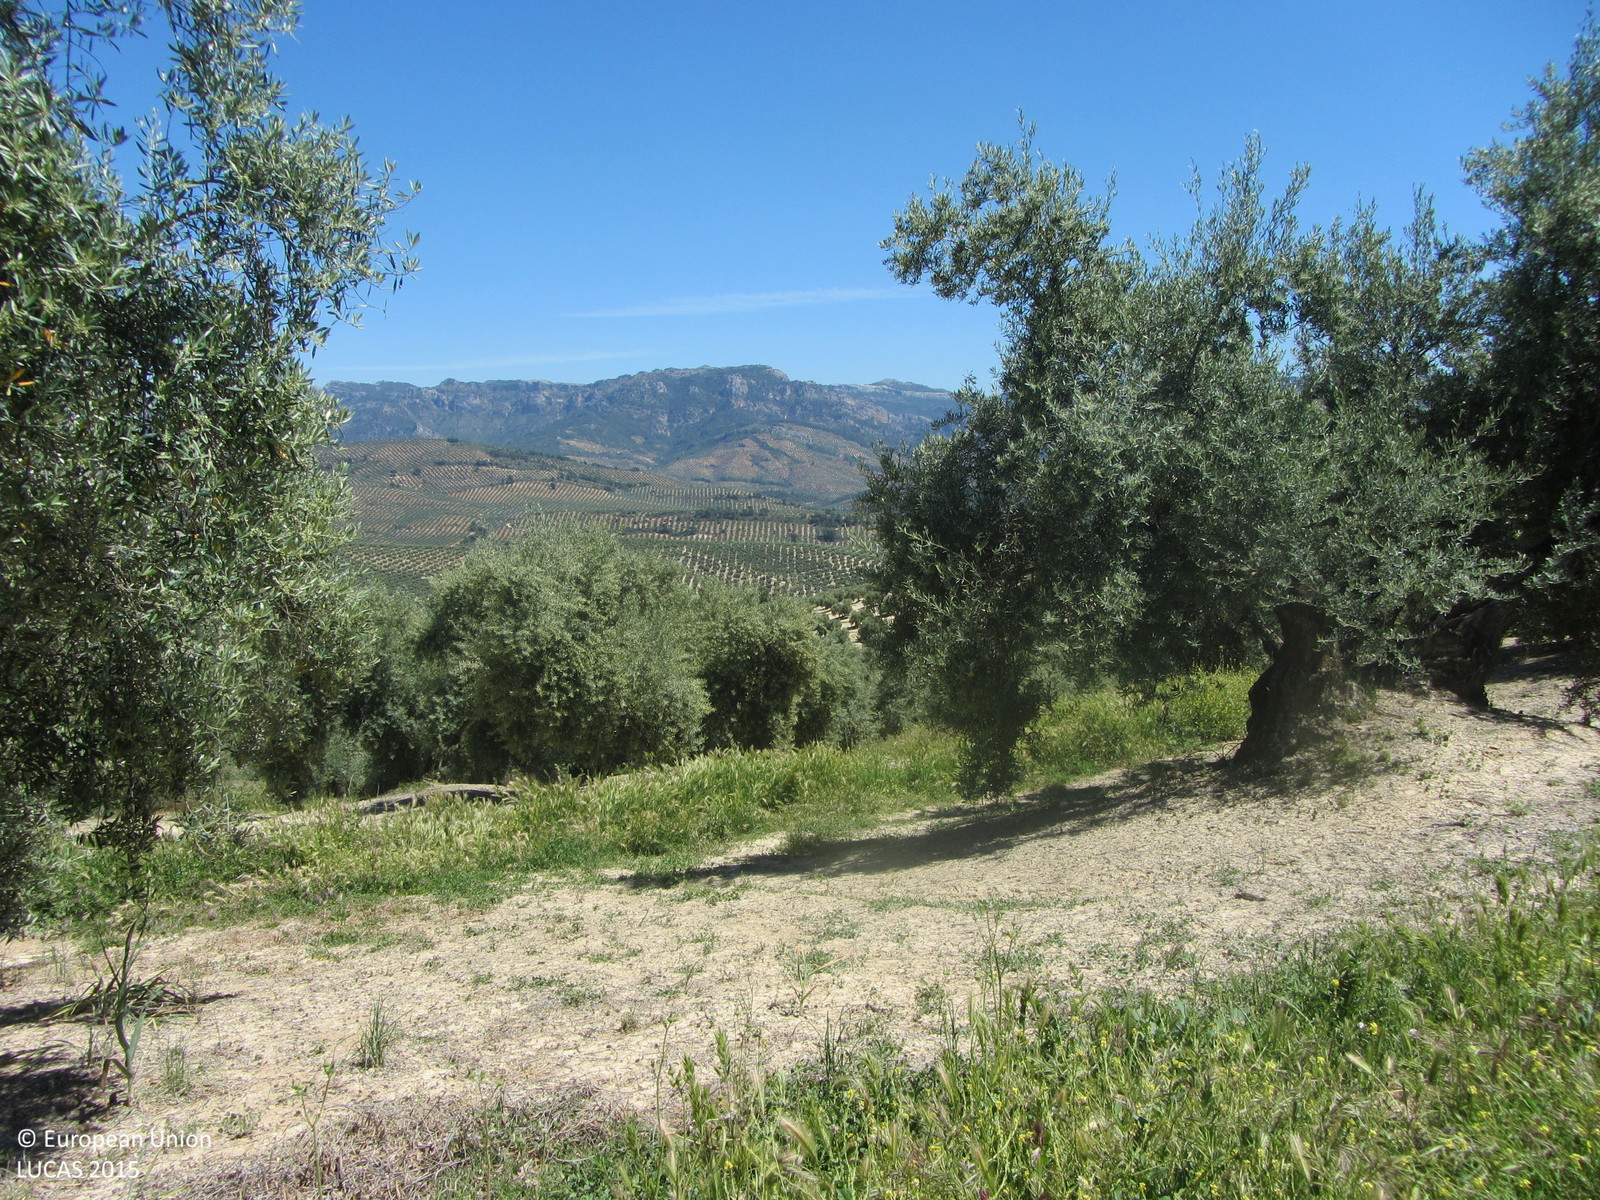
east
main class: Cropland
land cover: Olive groves
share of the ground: 25 - 50 %
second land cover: Spontaneously vegetated surfaces
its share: 25 - 50 %
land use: Agriculture (excluding fallow land and kitchen gardens)
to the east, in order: Olive groves; Spontaneously vegetated surfaces; Tracks; Olive groves; Grass margins; Olive groves
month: May
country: ES
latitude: 38.0906
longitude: -3.0535
